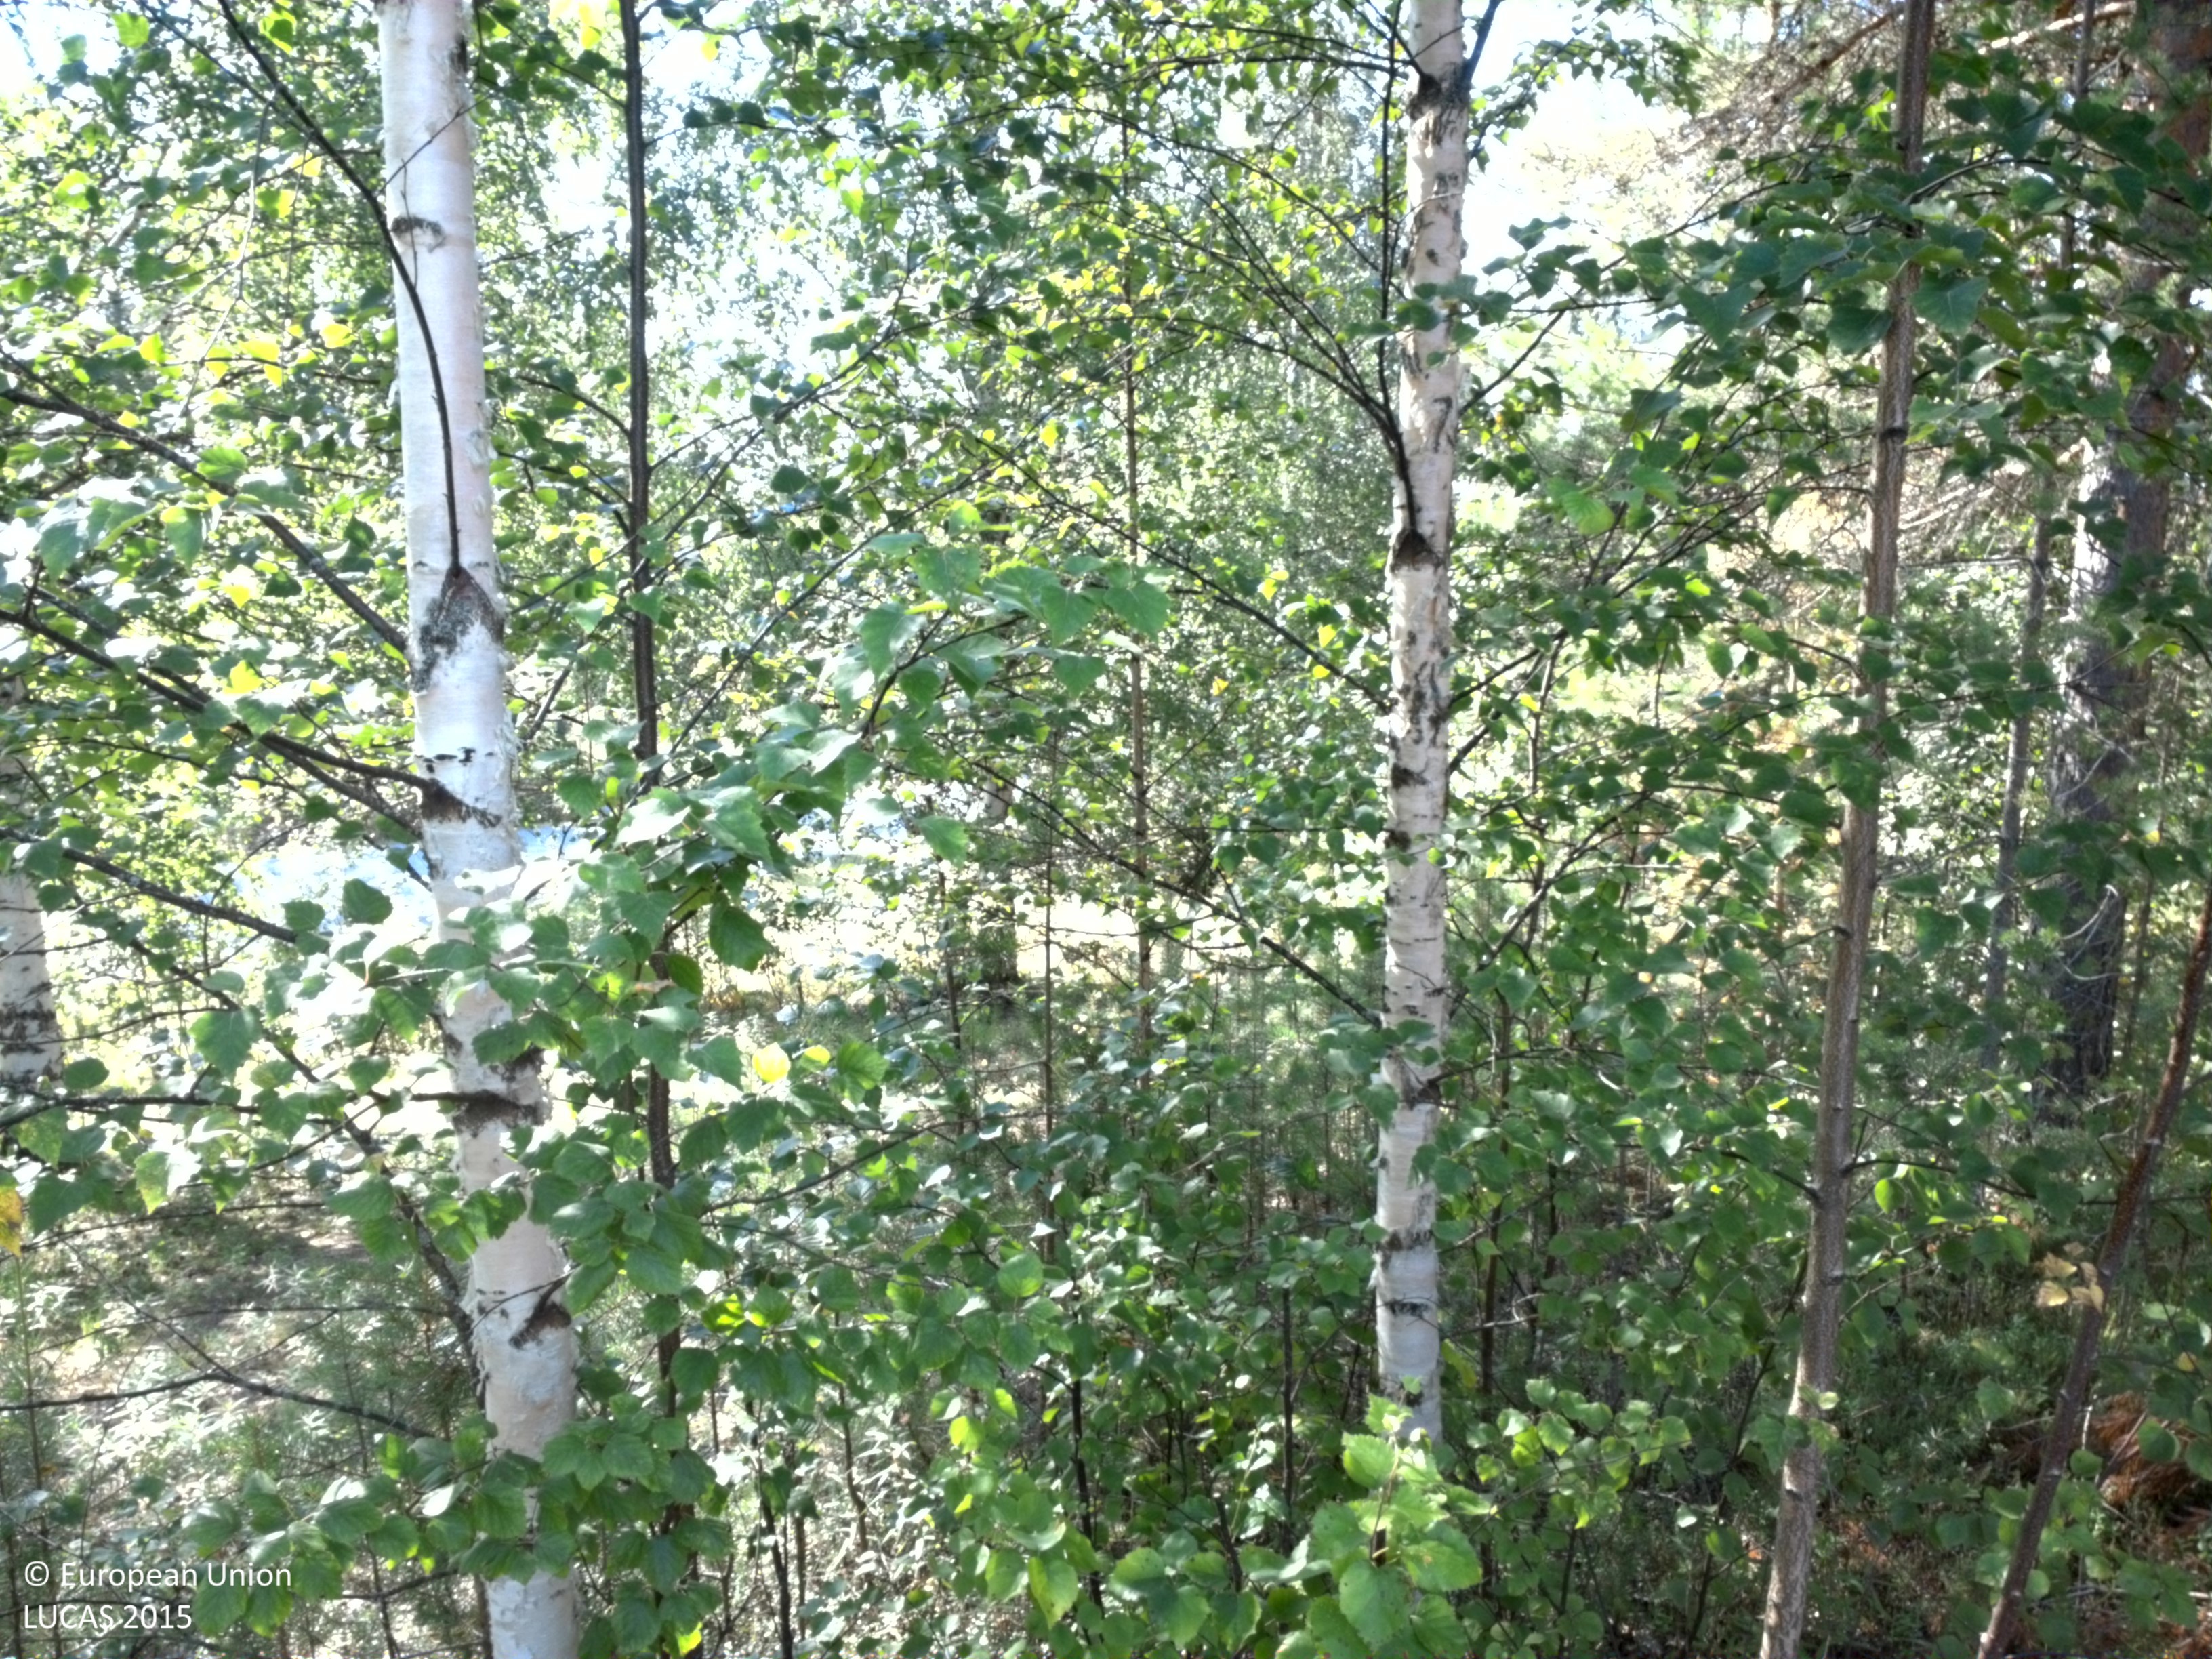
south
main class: Shrubland
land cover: Shrubland without tree cover
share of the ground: > 75 %
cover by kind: shrubs 100 %
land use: Forestry
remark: Clear cut
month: August
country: SE
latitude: 64.5766
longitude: 18.7157
